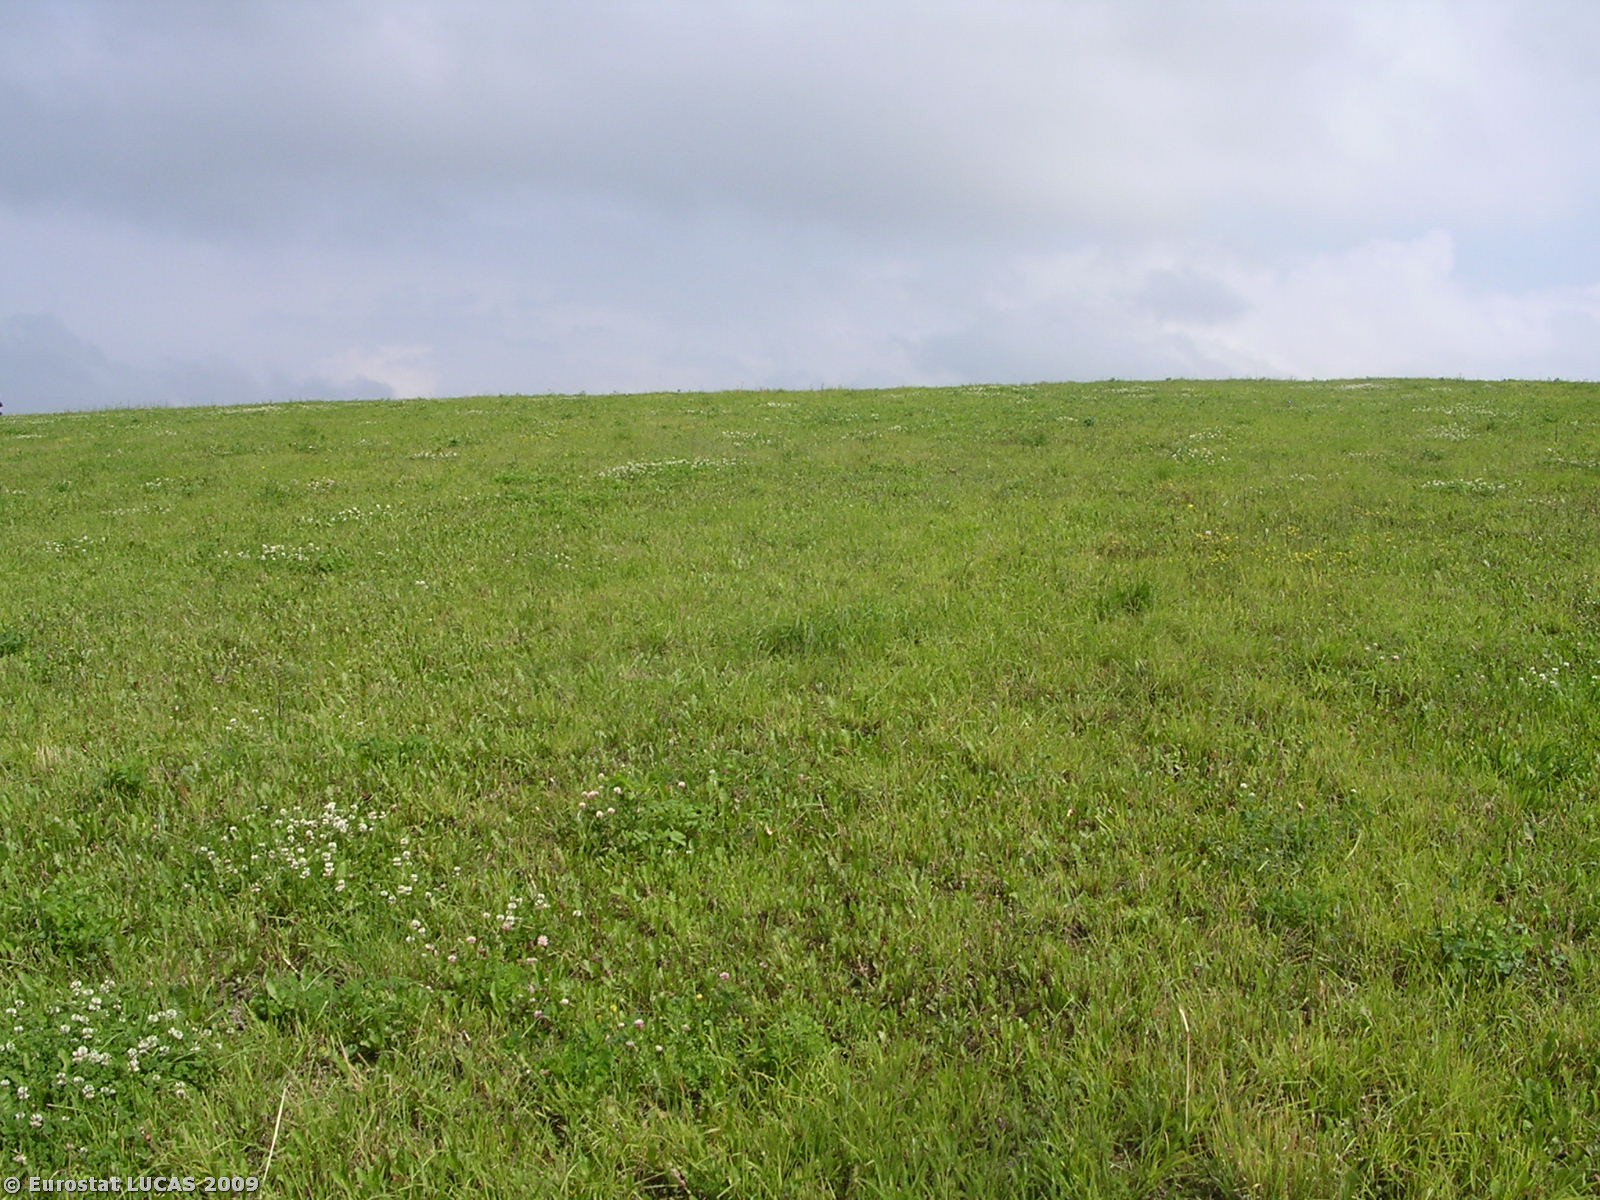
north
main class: Grassland
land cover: Grassland without tree/shrub cover
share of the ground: > 75 %
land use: Agriculture (excluding fallow land and kitchen gardens)
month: June
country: CZ
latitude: 50.6439
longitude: 14.2863
